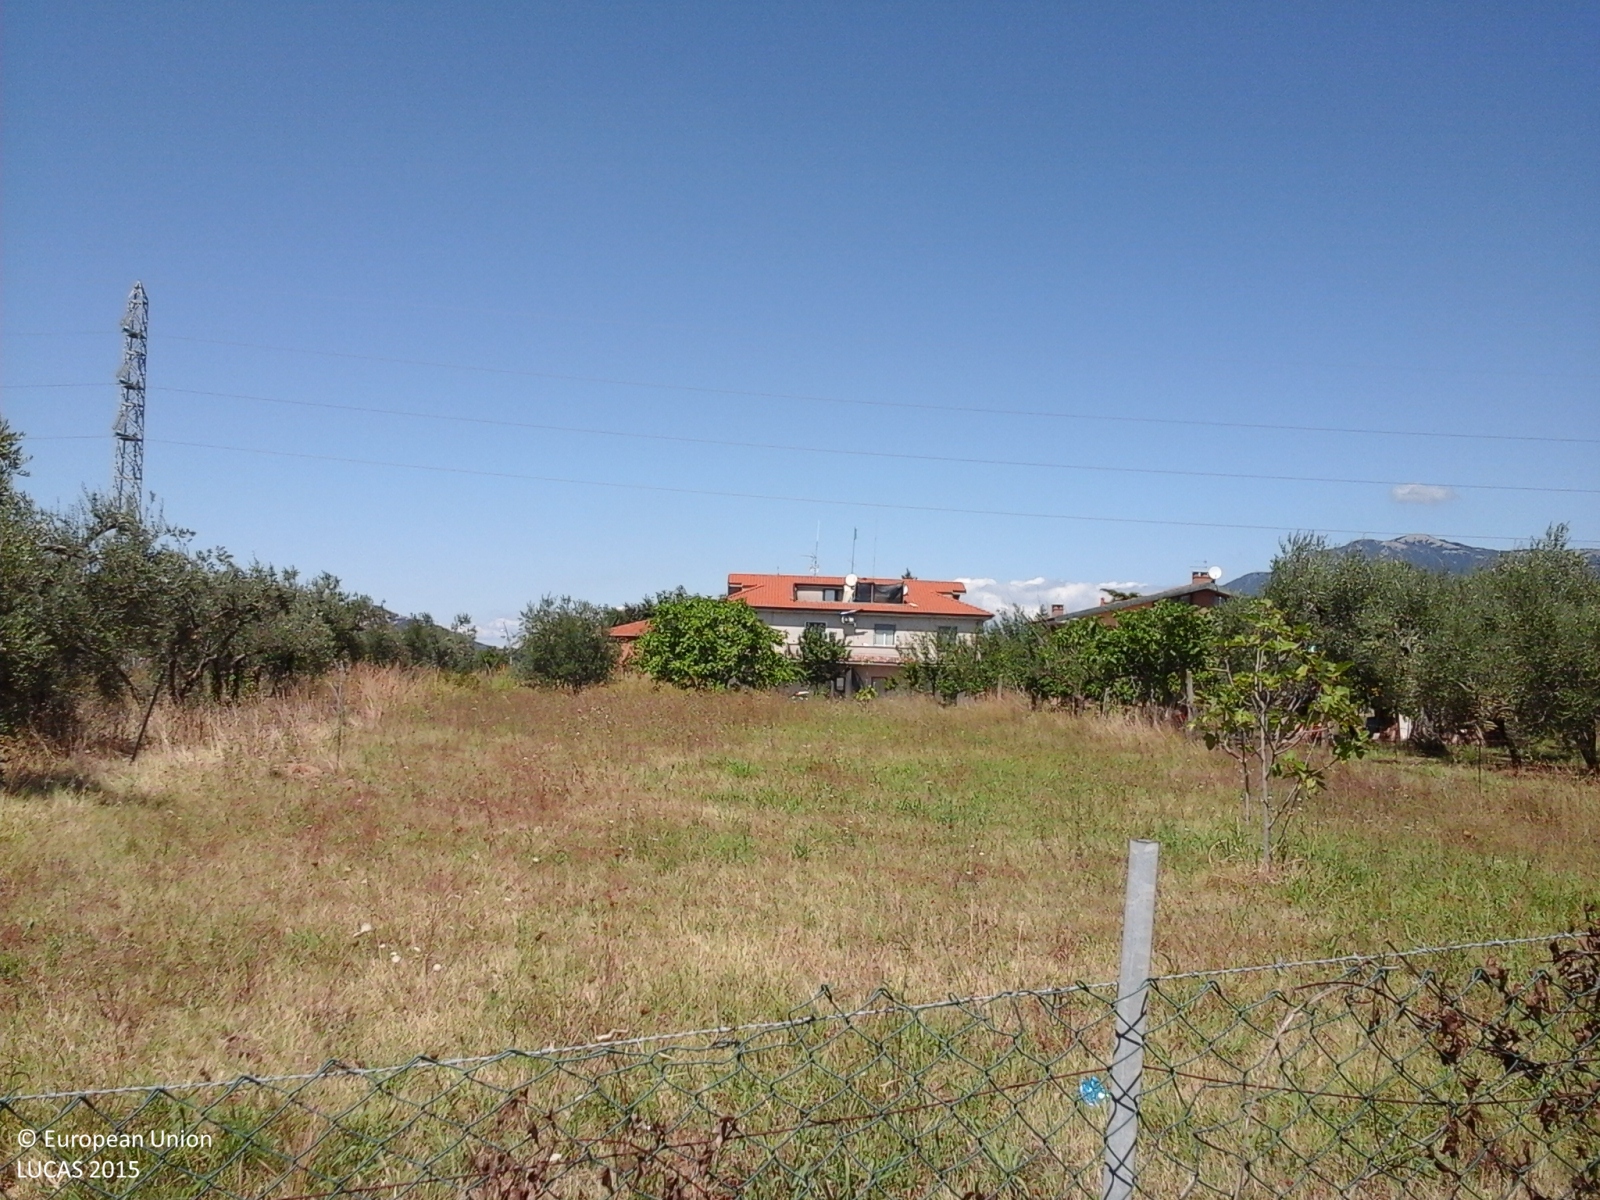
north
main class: Cropland
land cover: Olive groves
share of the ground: 25 - 50 %
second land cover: Grassland without tree/shrub cover
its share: > 75 %
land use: Agriculture (excluding fallow land and kitchen gardens)
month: August
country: IT
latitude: 41.9652
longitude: 12.7772
